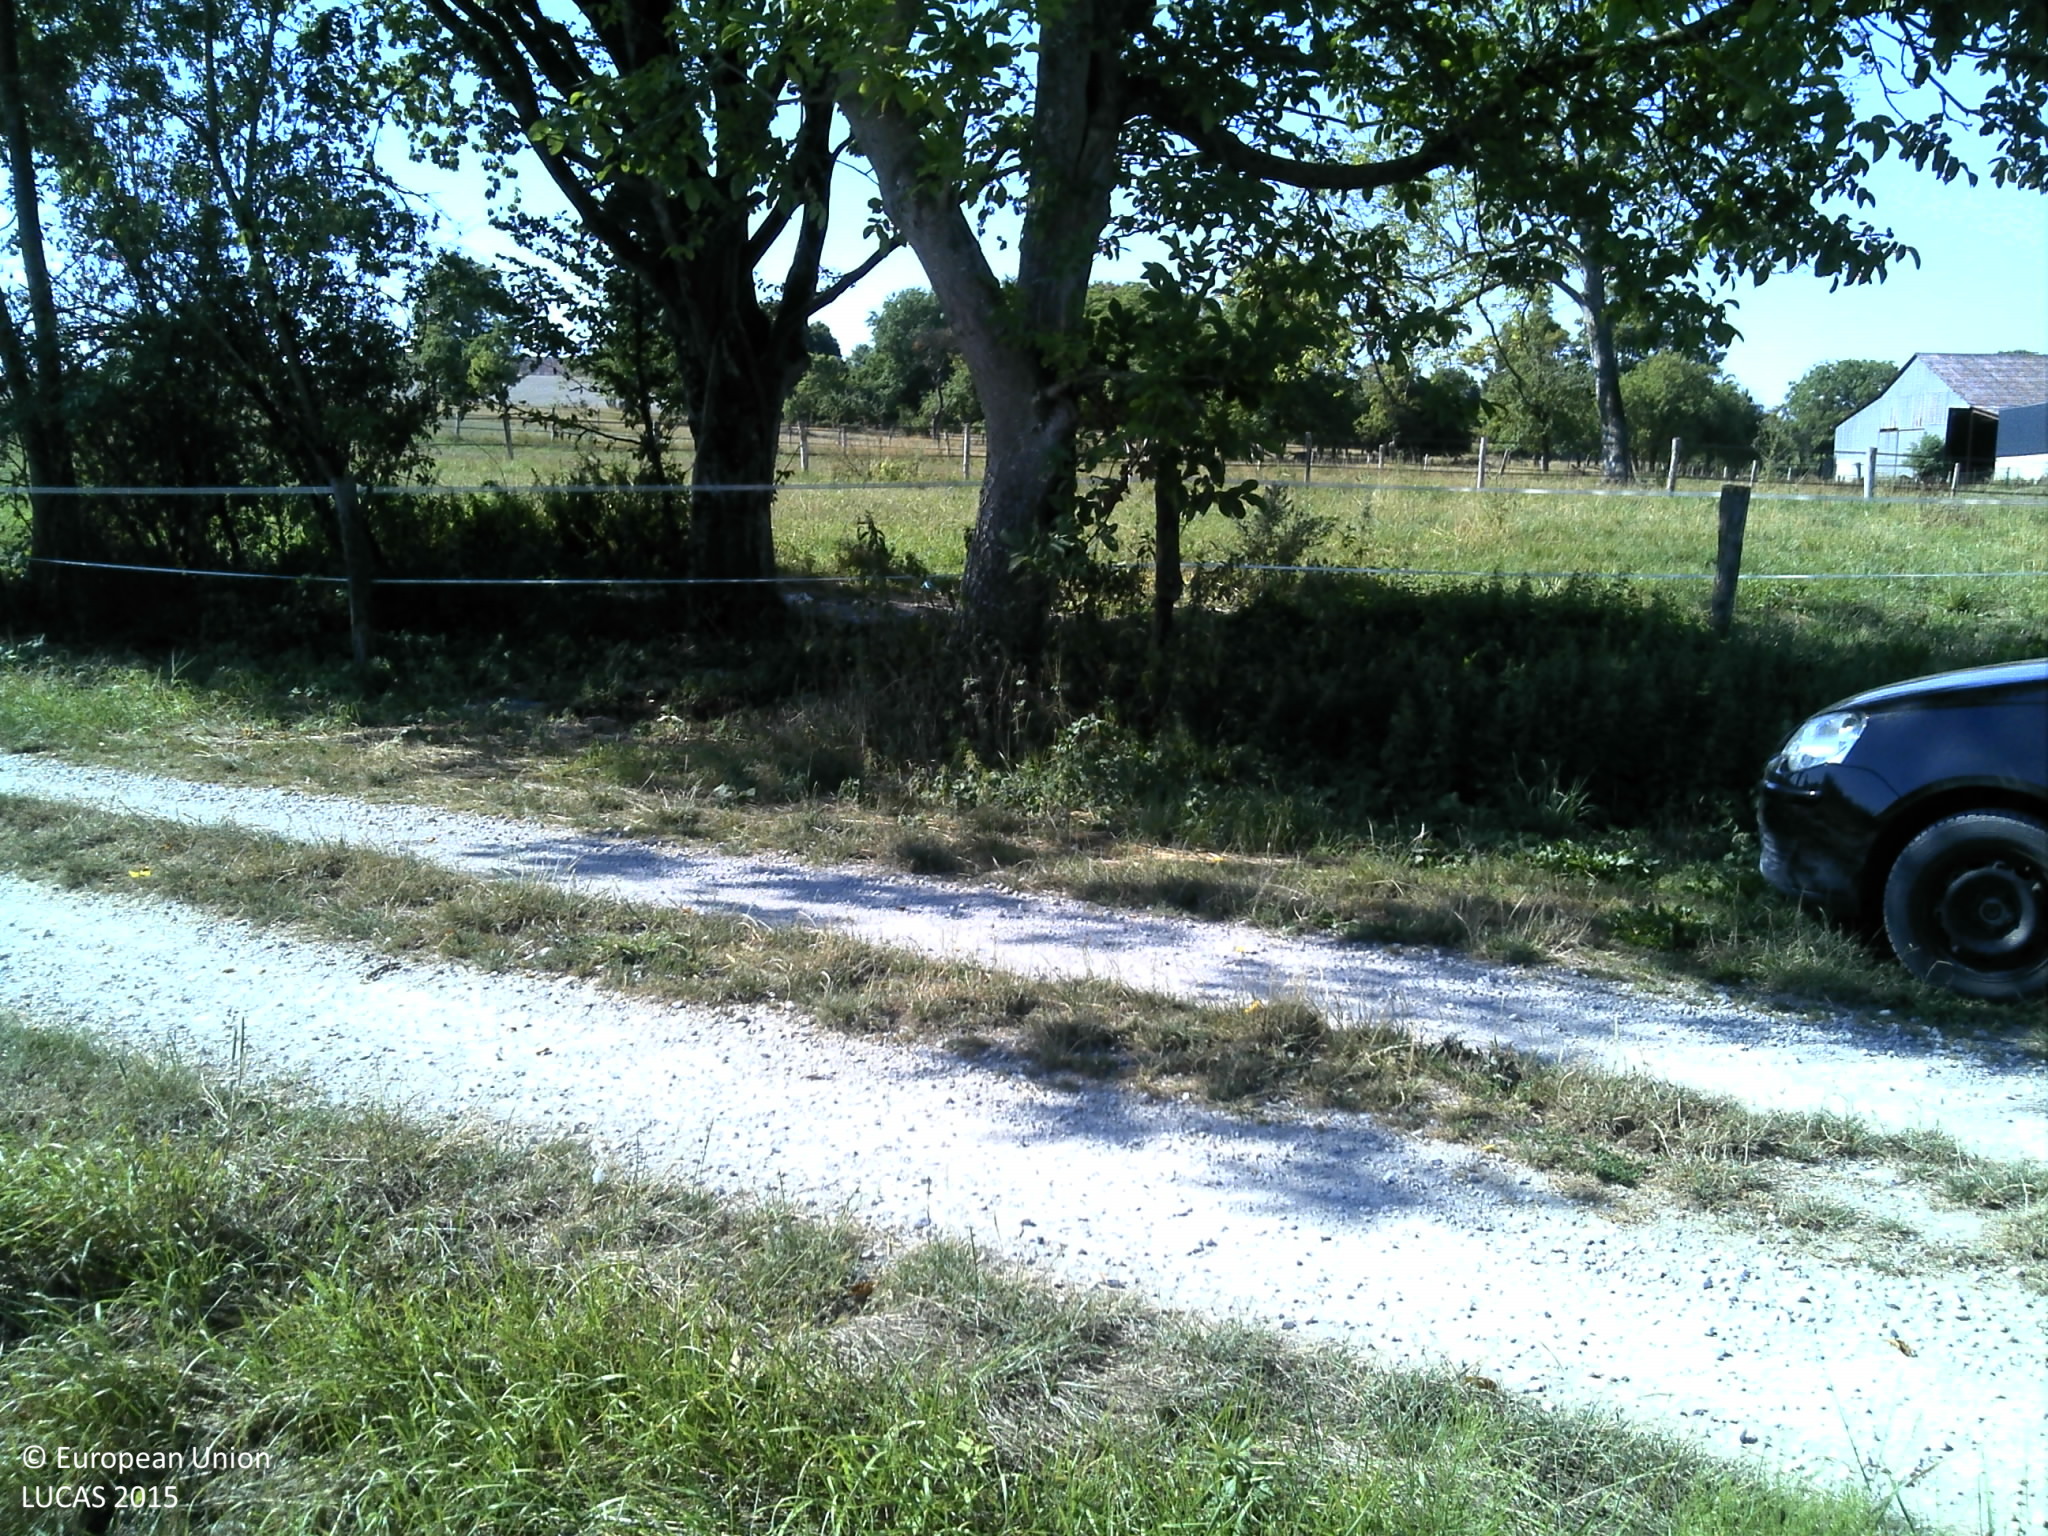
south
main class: Cropland
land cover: Common wheat
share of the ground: > 75 %
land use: Agriculture (excluding fallow land and kitchen gardens)
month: August
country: FR
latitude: 49.1645
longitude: 4.7996
